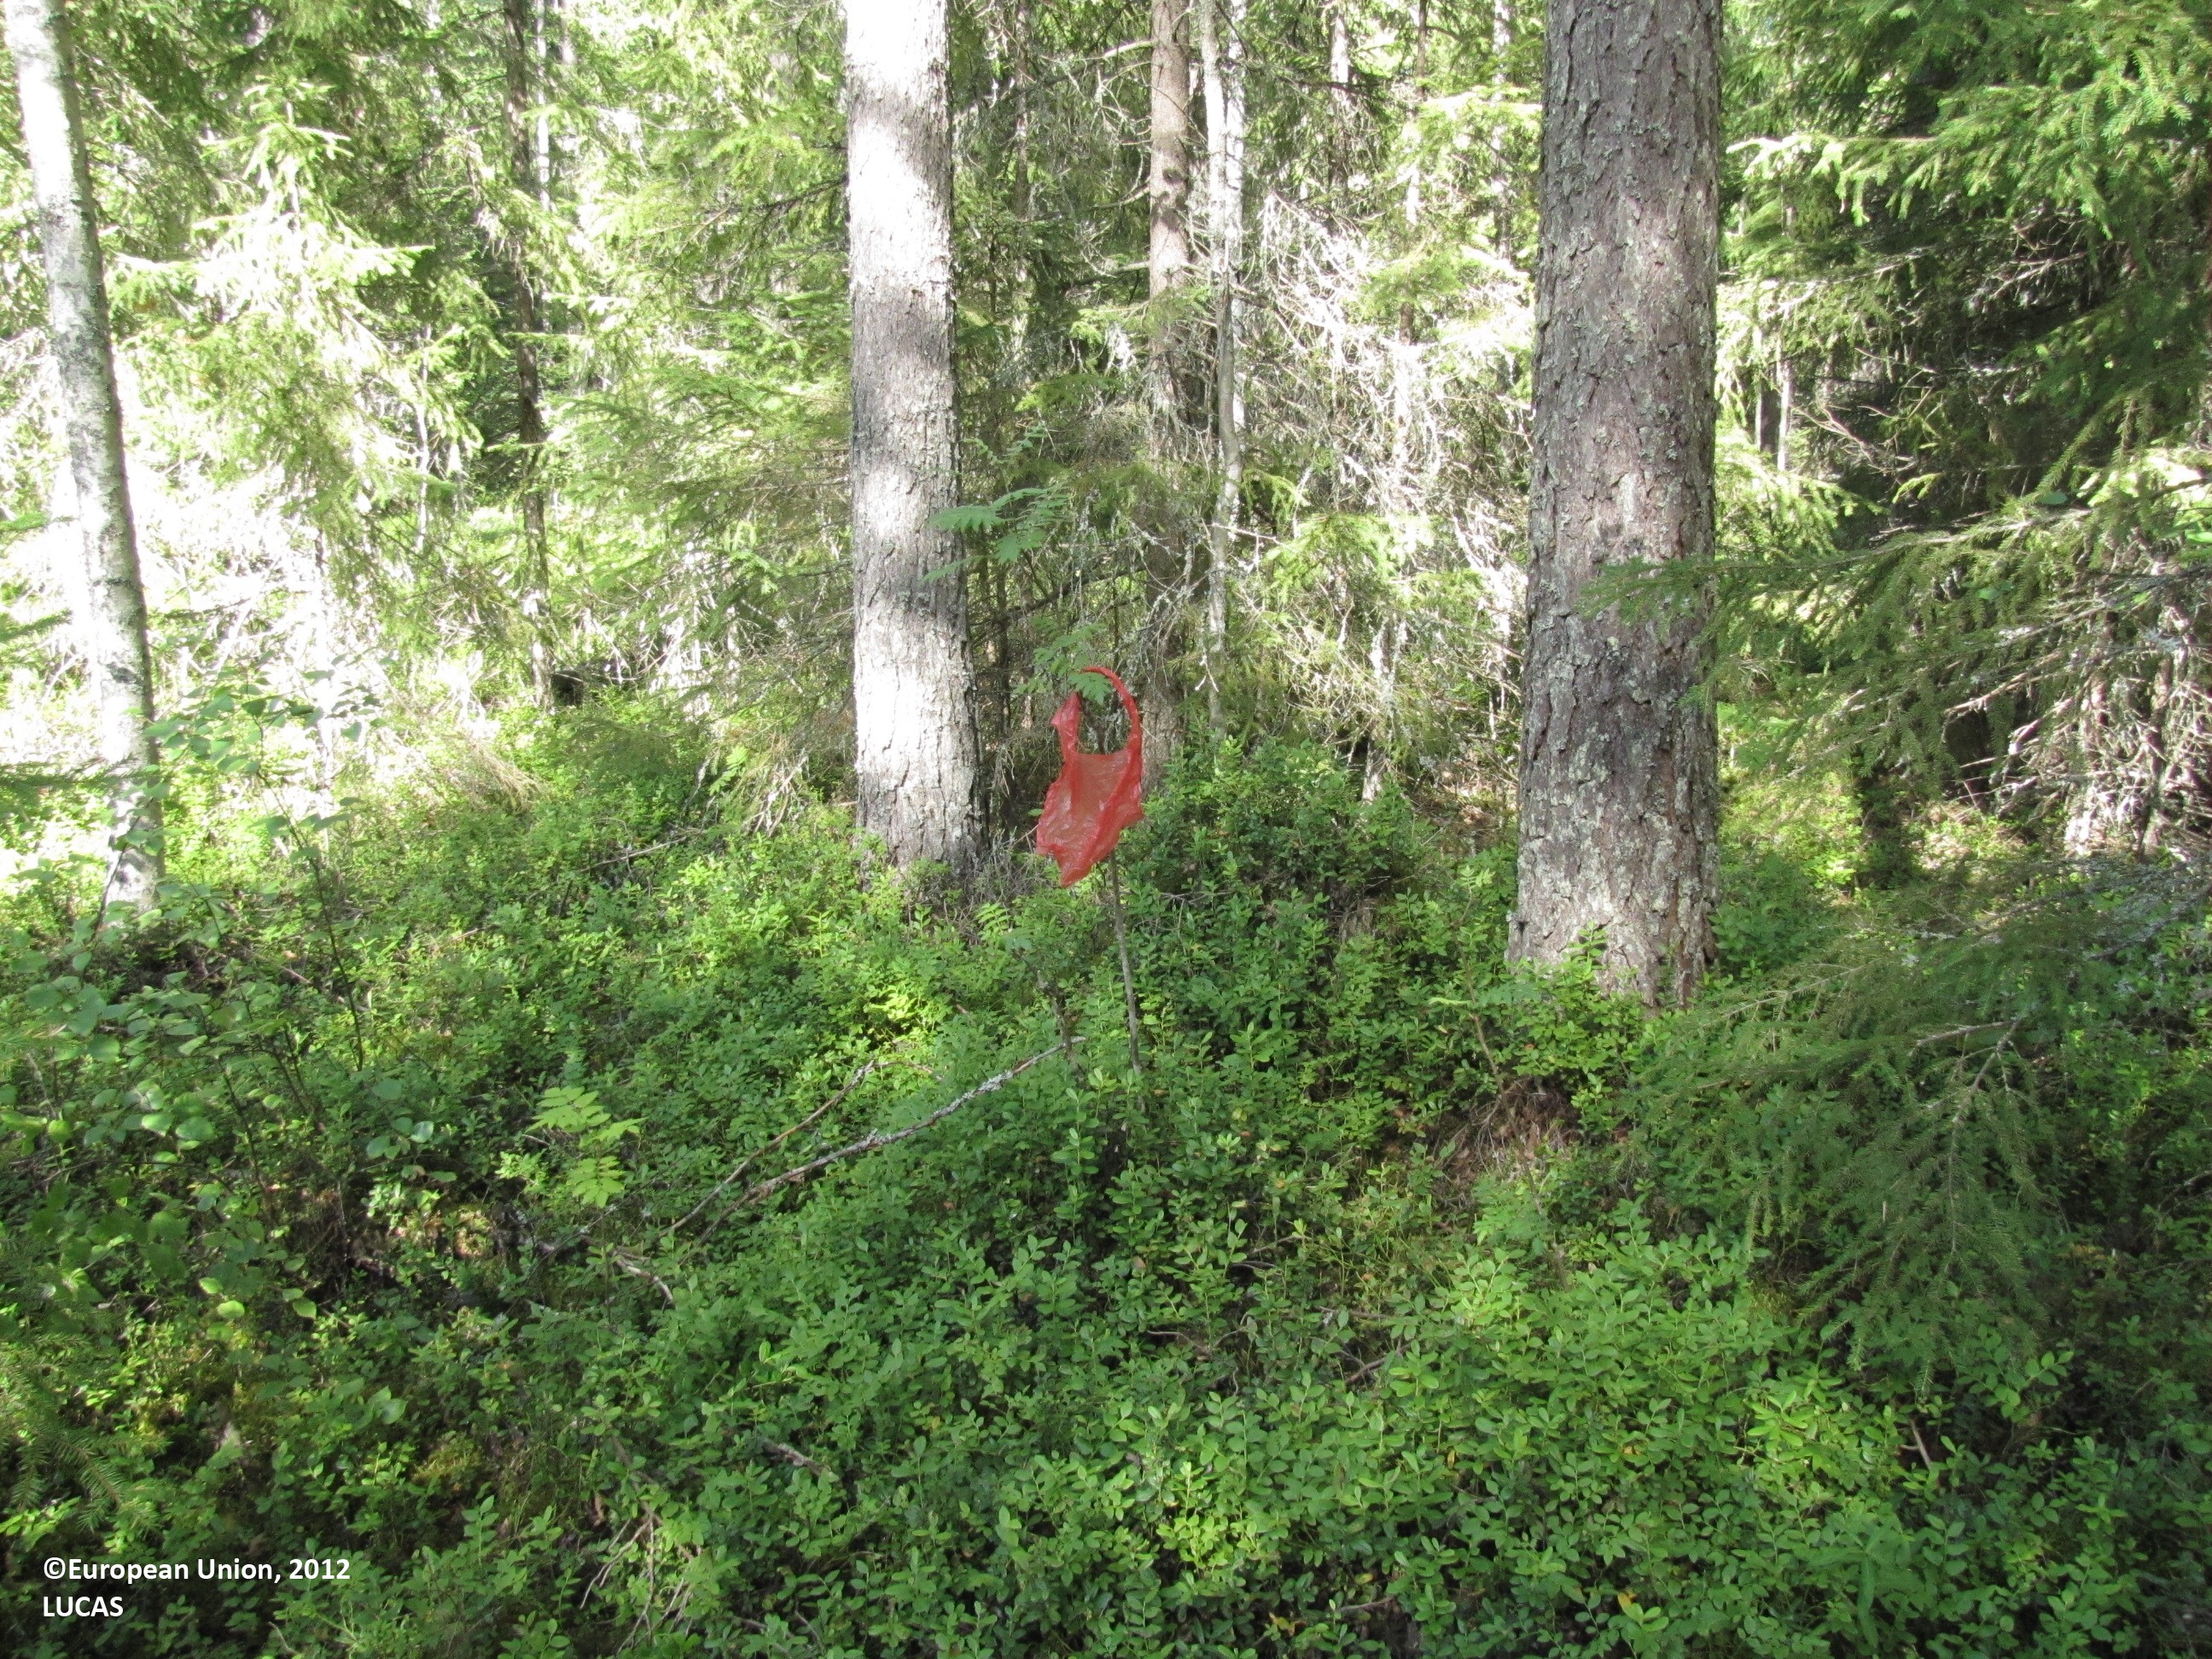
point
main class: Woodland
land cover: Pine dominated coniferous woodland
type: boreal forest
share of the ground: > 75 %
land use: Forestry
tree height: > 5 m
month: July
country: FI
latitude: 62.3515
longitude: 23.0654
